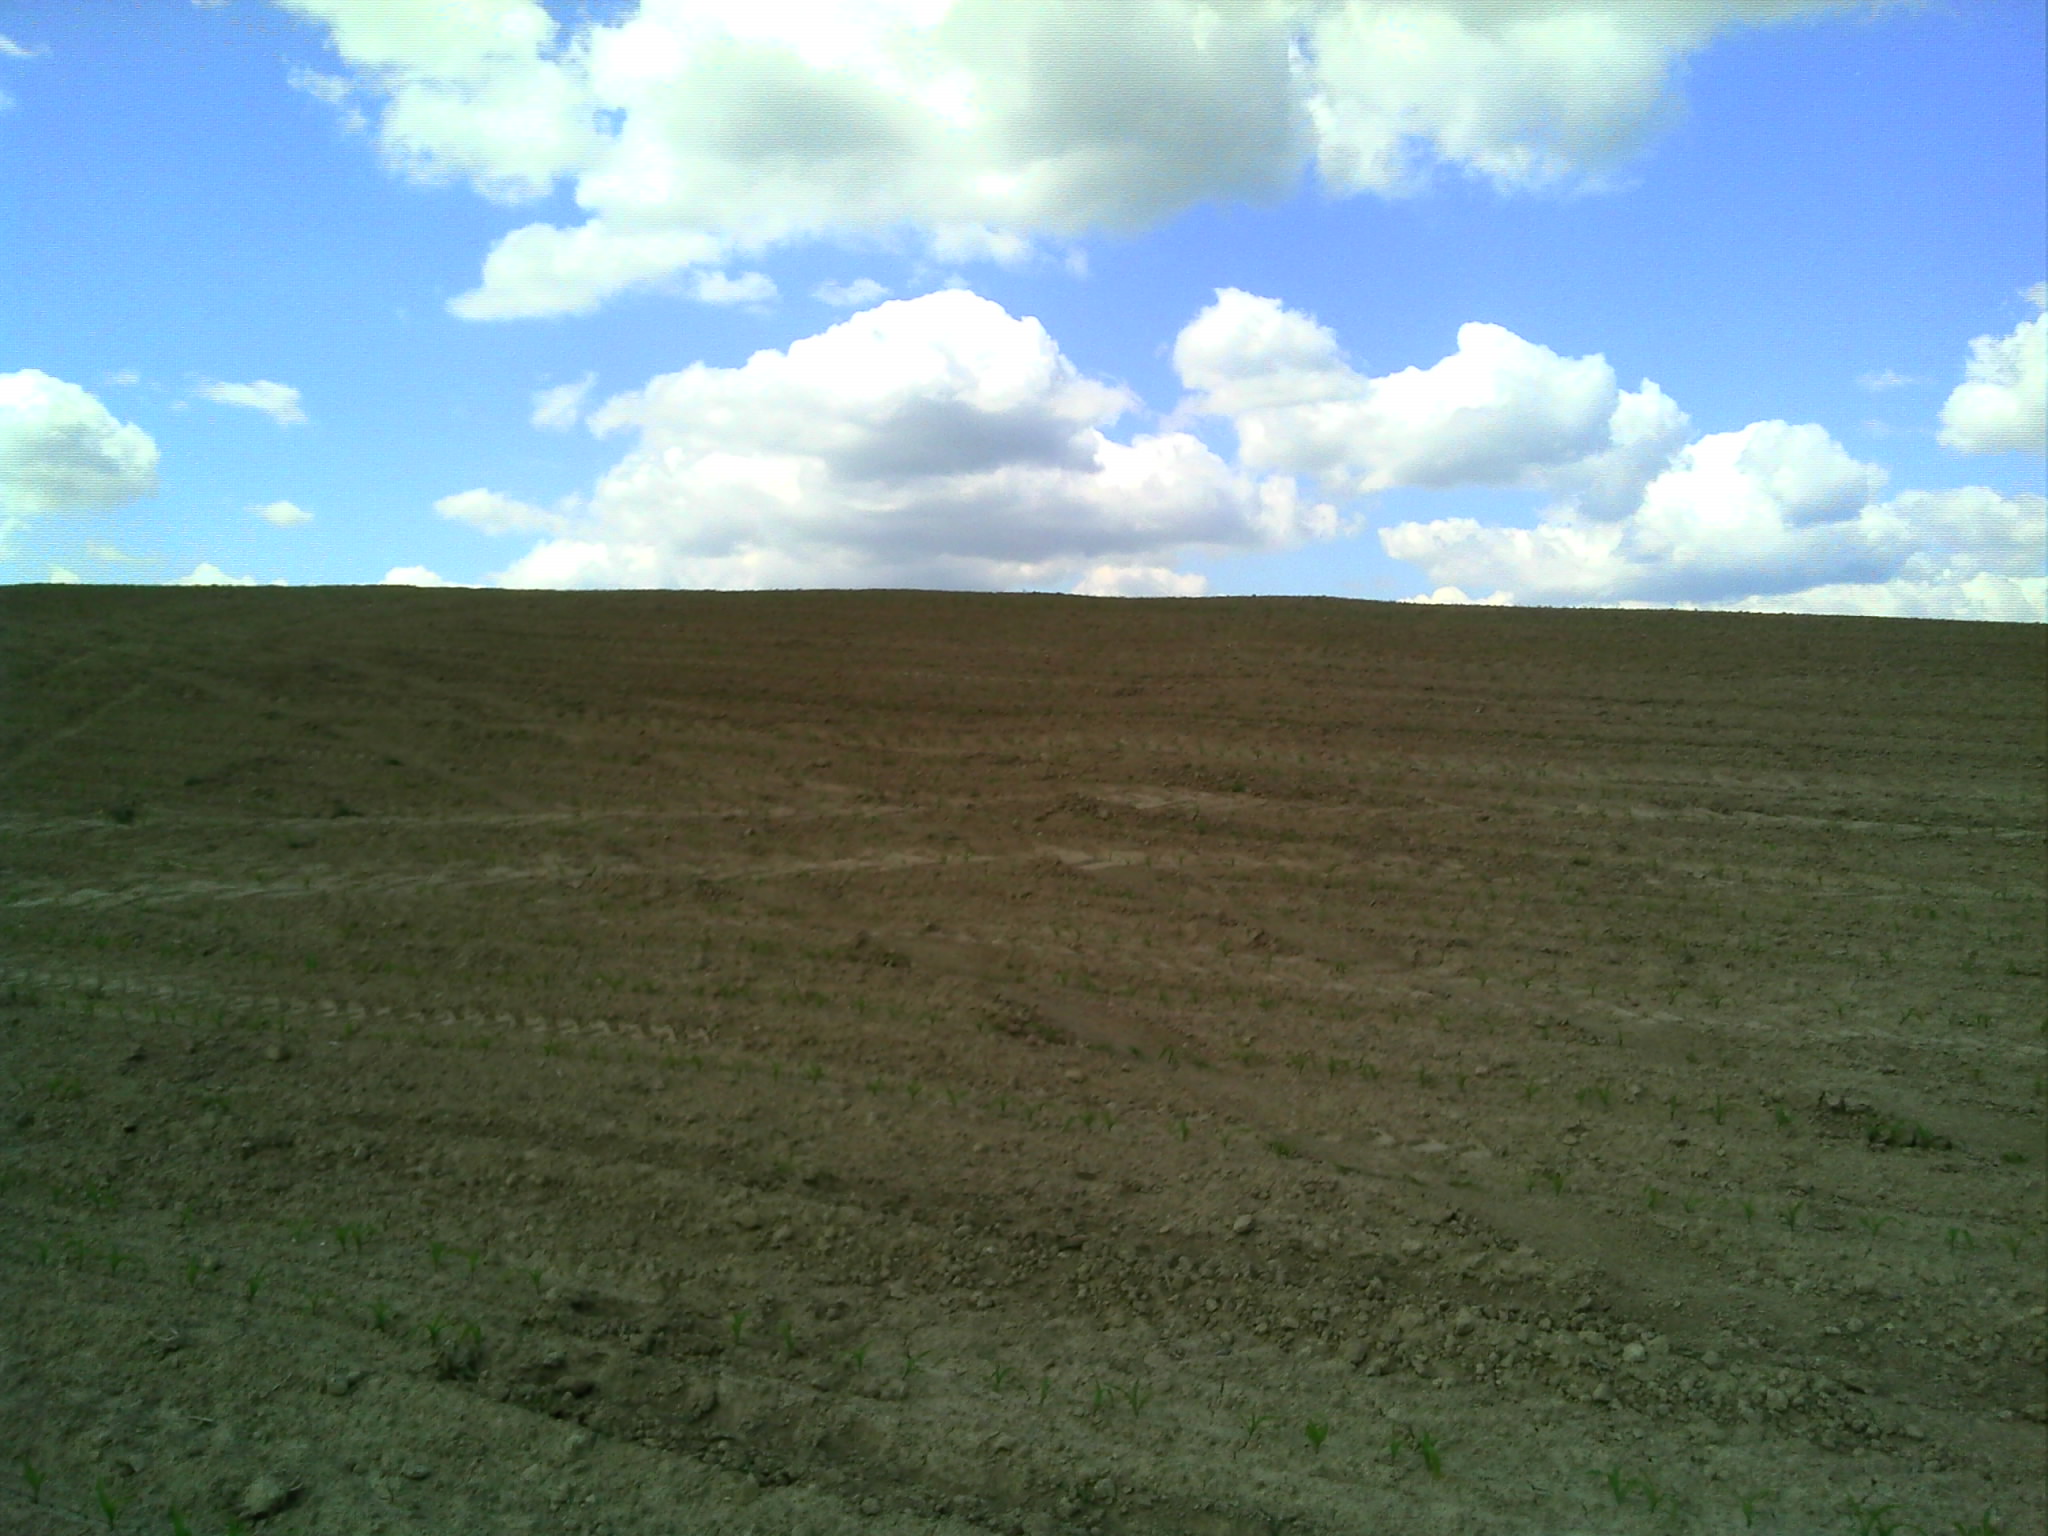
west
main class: Cropland
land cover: Maize
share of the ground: > 75 %
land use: Agriculture (excluding fallow land and kitchen gardens)
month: May
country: LU
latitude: 49.5844
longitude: 6.3065
